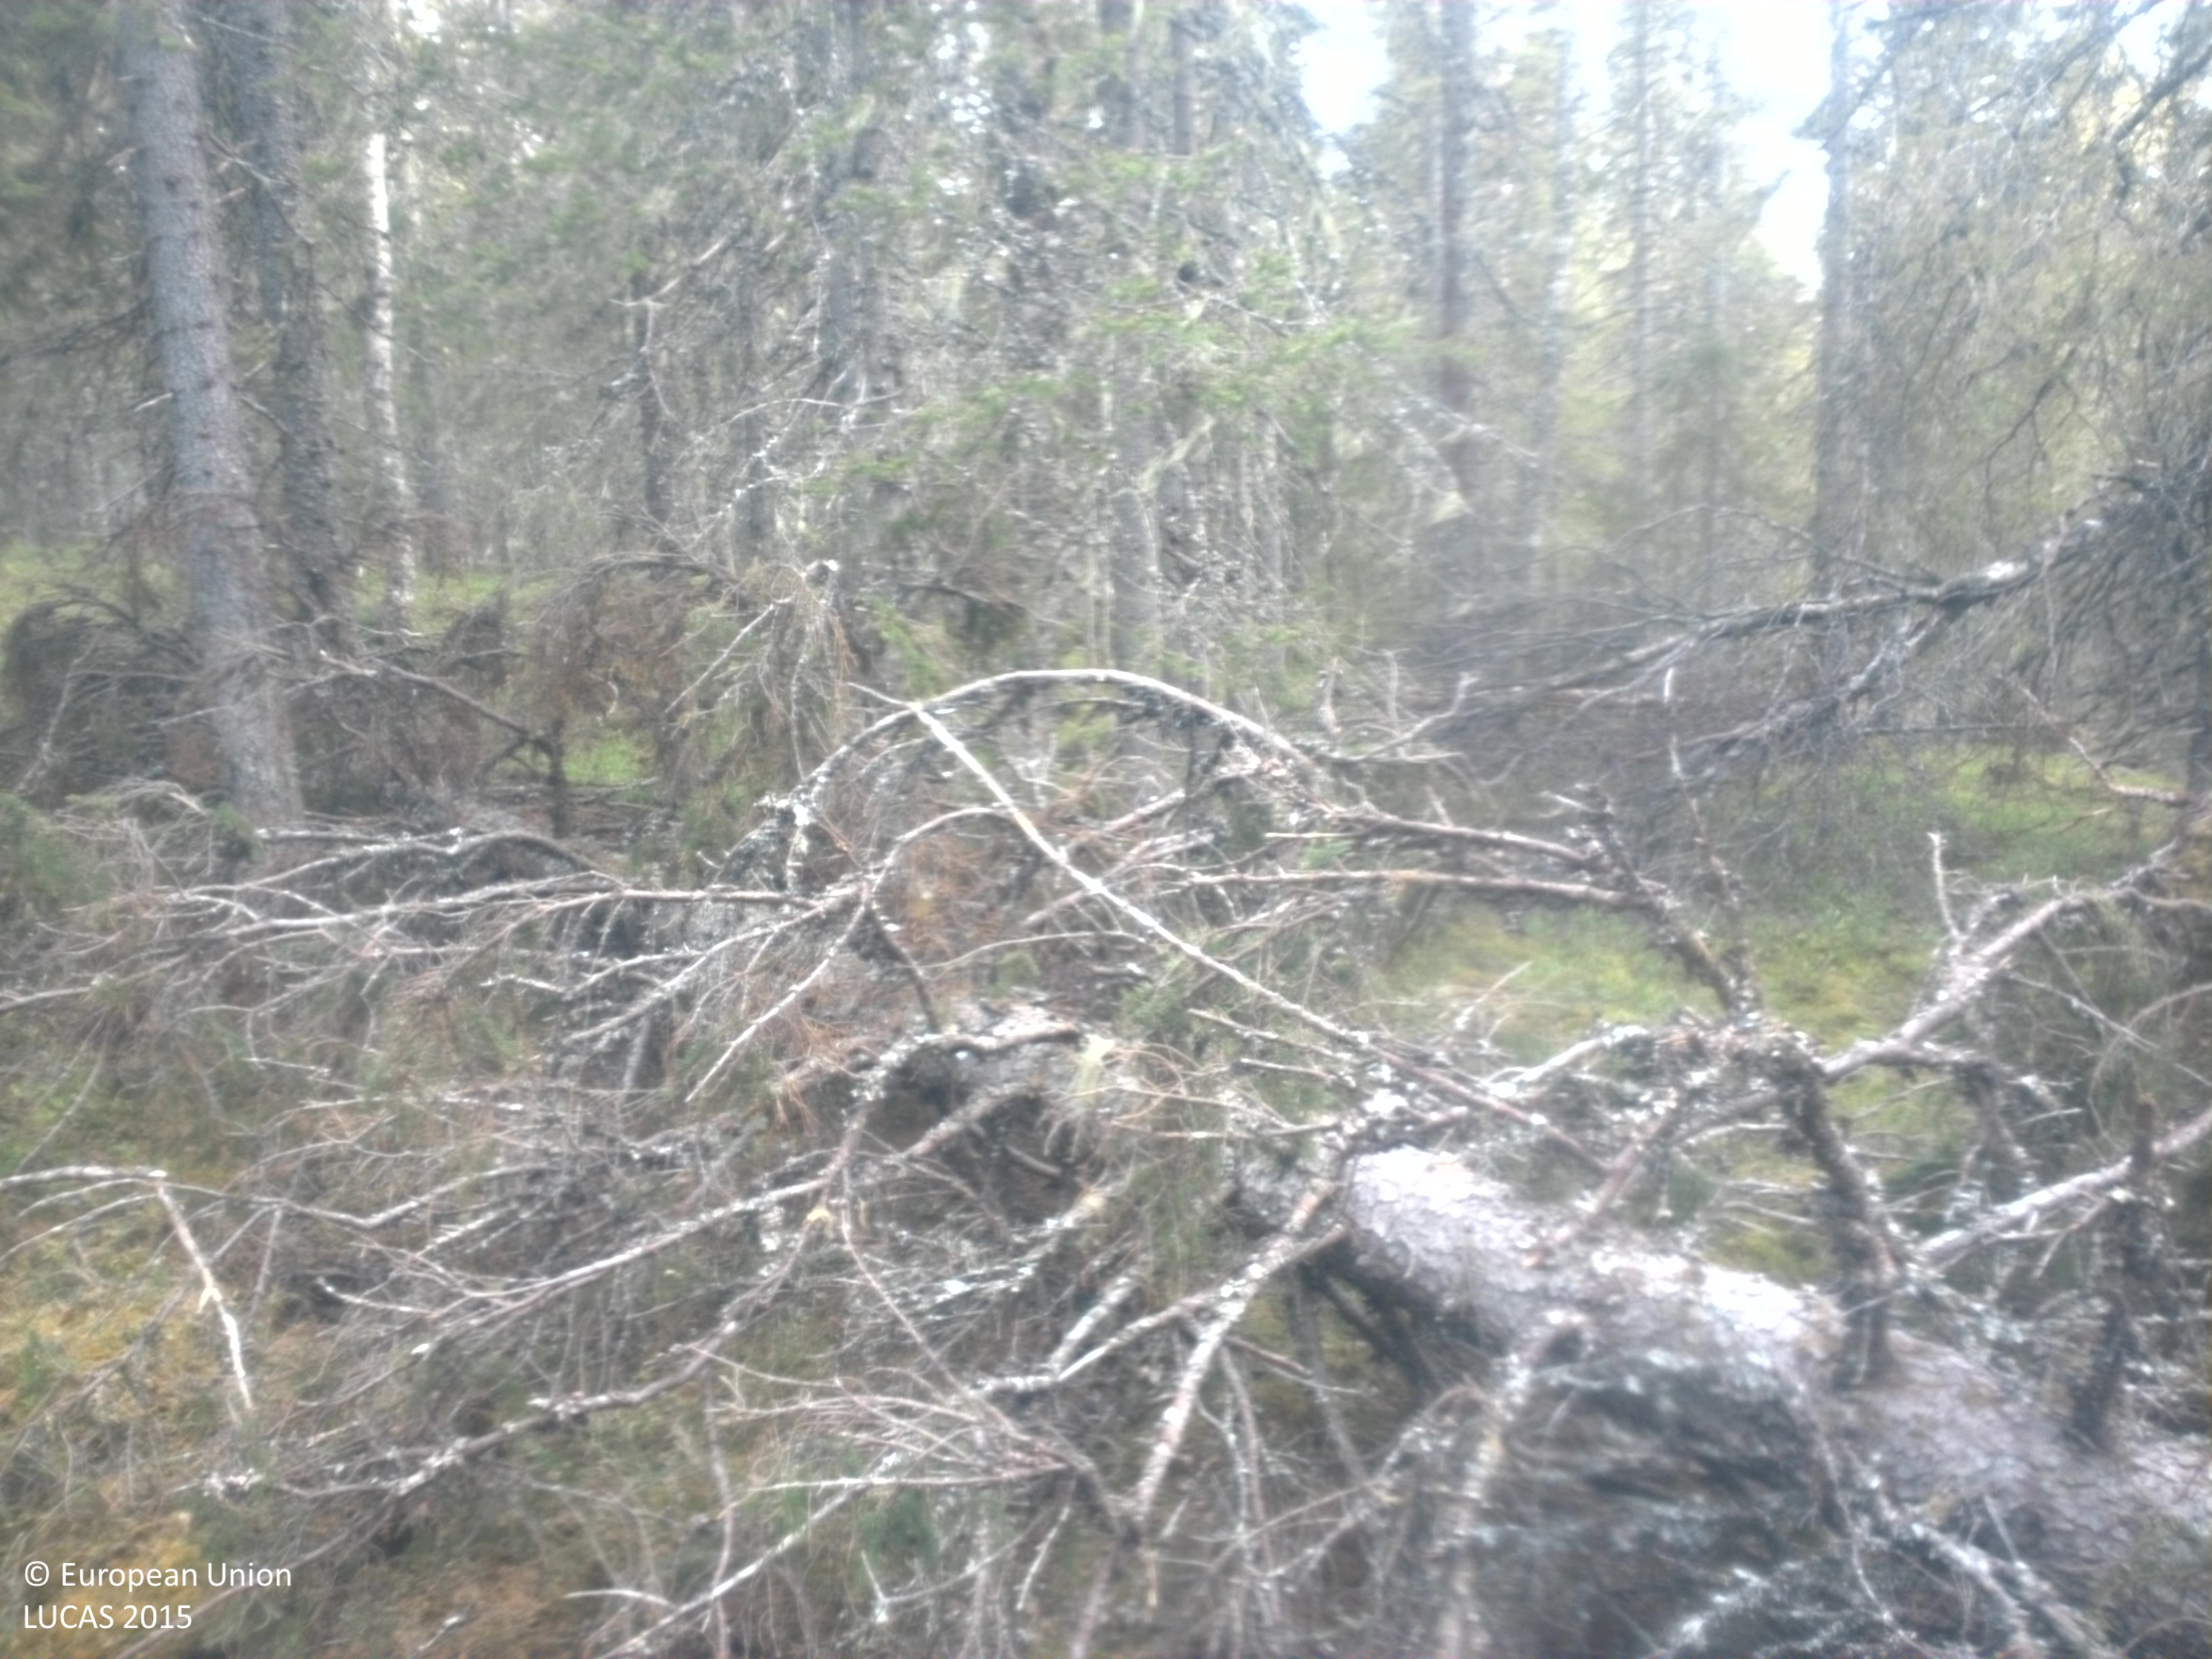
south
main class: Woodland
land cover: Spruce dominated coniferous woodland
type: boreal forest
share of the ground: 25 - 50 %
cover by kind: coniferous forest trees 45 %, herbaceous plants 25 %, lichens and mosses 10 %, unconsolidated bare surface 10 %, broadleaved forest trees 5 %, shrubs 5 %
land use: Forestry
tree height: > 5 m
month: June
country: SE
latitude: 64.4463
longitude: 17.7178
